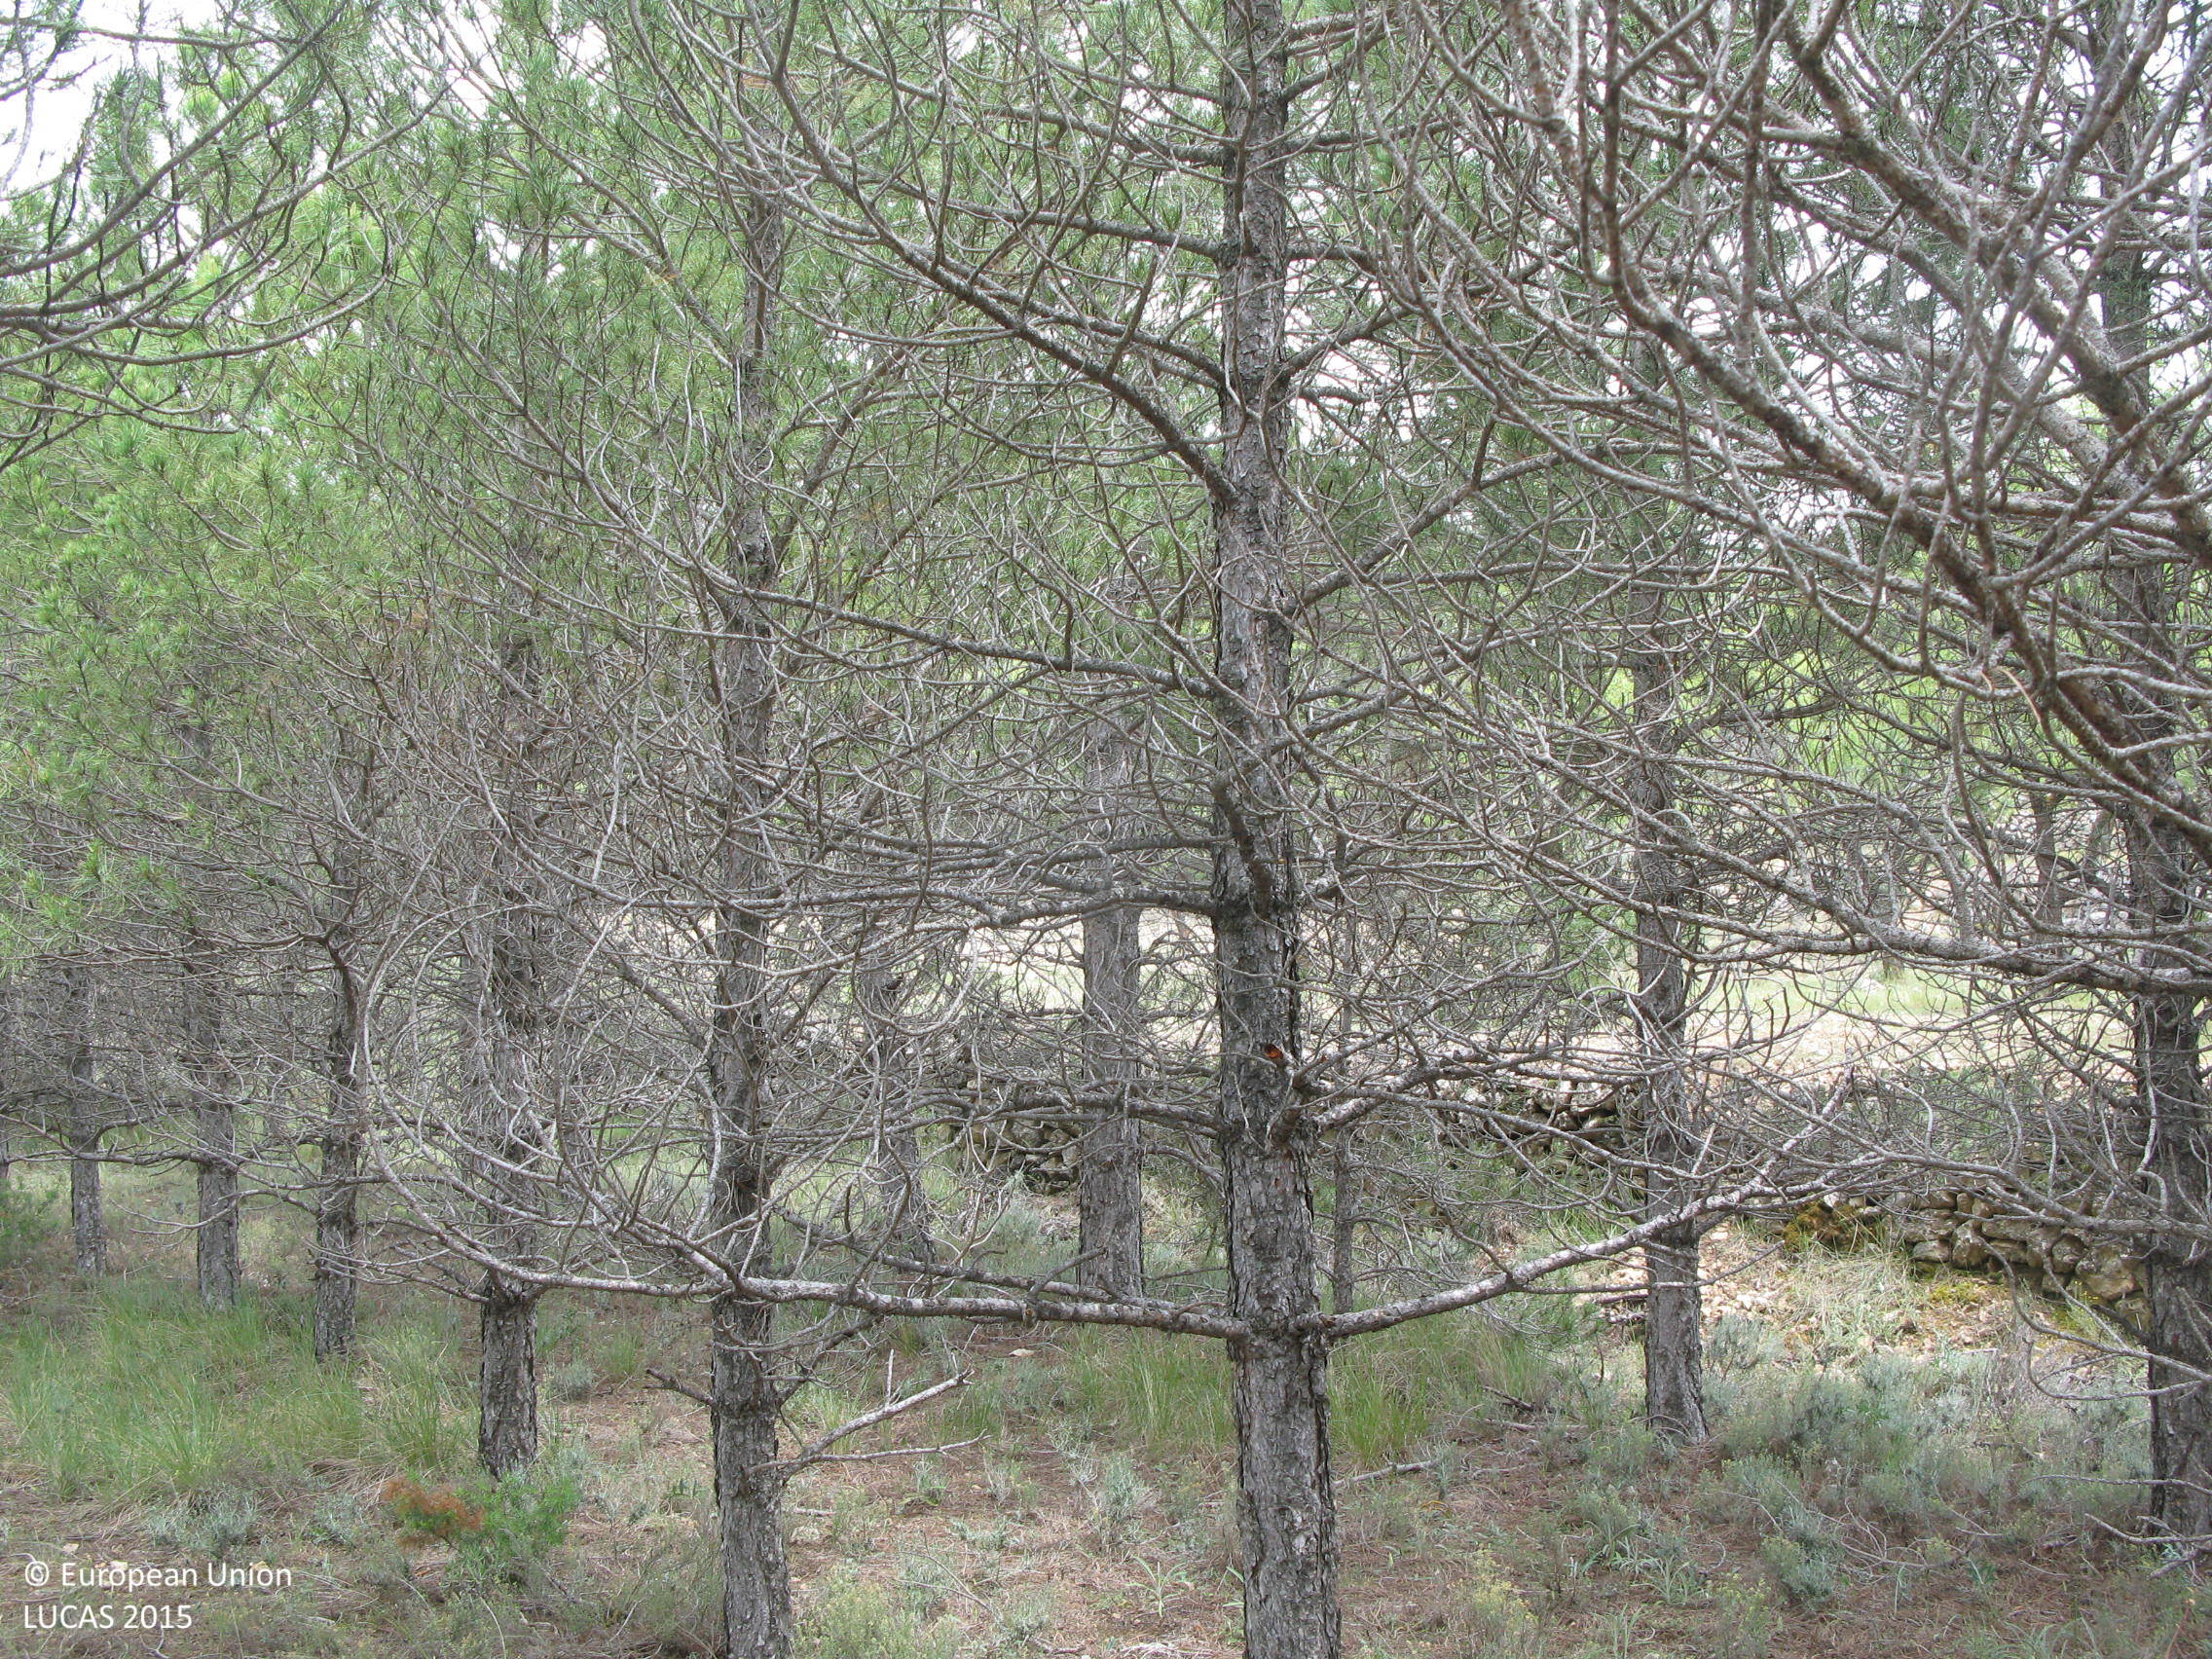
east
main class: Woodland
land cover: Pine dominated coniferous woodland
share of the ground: > 75 %
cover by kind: coniferous forest trees 80 %, herbaceous plants 20 %
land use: Forestry
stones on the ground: 10 - 25 %
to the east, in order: Pine dominated coniferous woodland; Dry stone walls; Grass margins; Nuts trees; Pine dominated coniferous woodland; Shrubland with sparse tree cover; Shrubland without tree cover; Shrubland with sparse tree cover; Pine dominated coniferous woodland
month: June
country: ES
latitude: 40.0408
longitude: -1.2245
